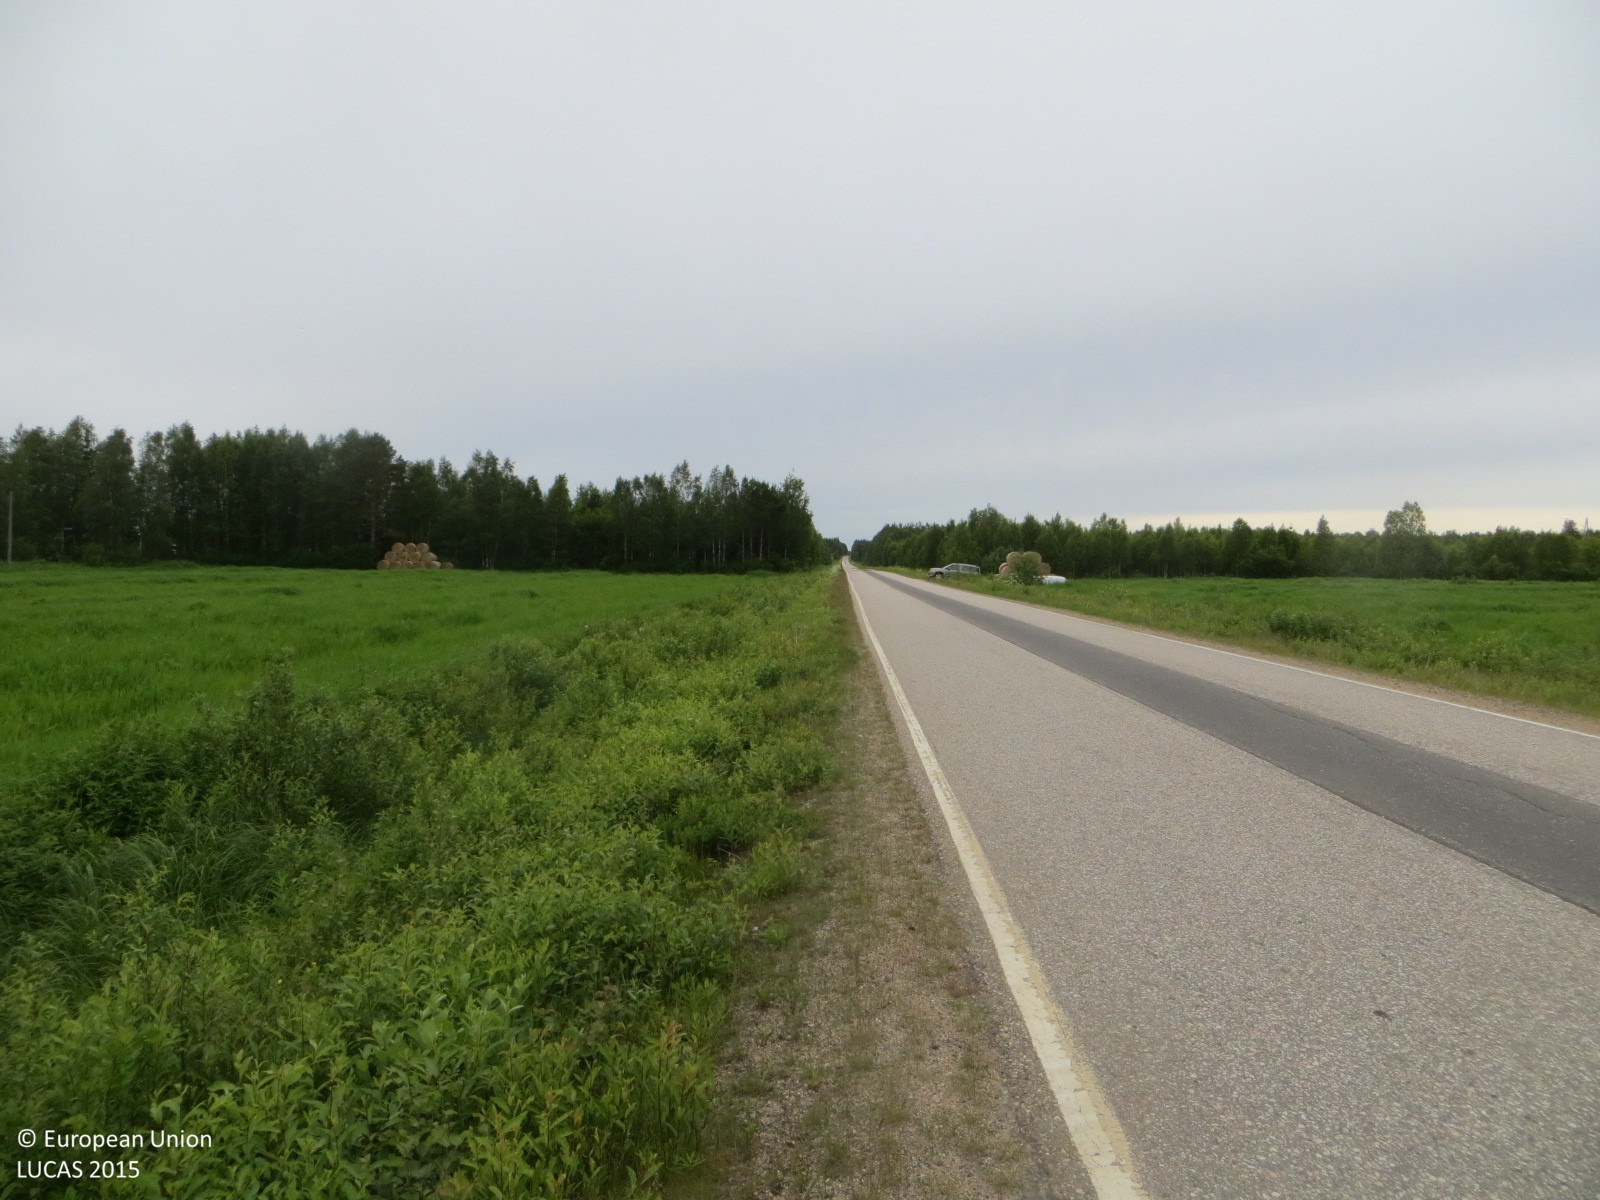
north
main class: Cropland
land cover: Permanent industrial crops
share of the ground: > 75 %
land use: Agriculture (excluding fallow land and kitchen gardens)
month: July
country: FI
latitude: 65.5251
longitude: 25.9878
